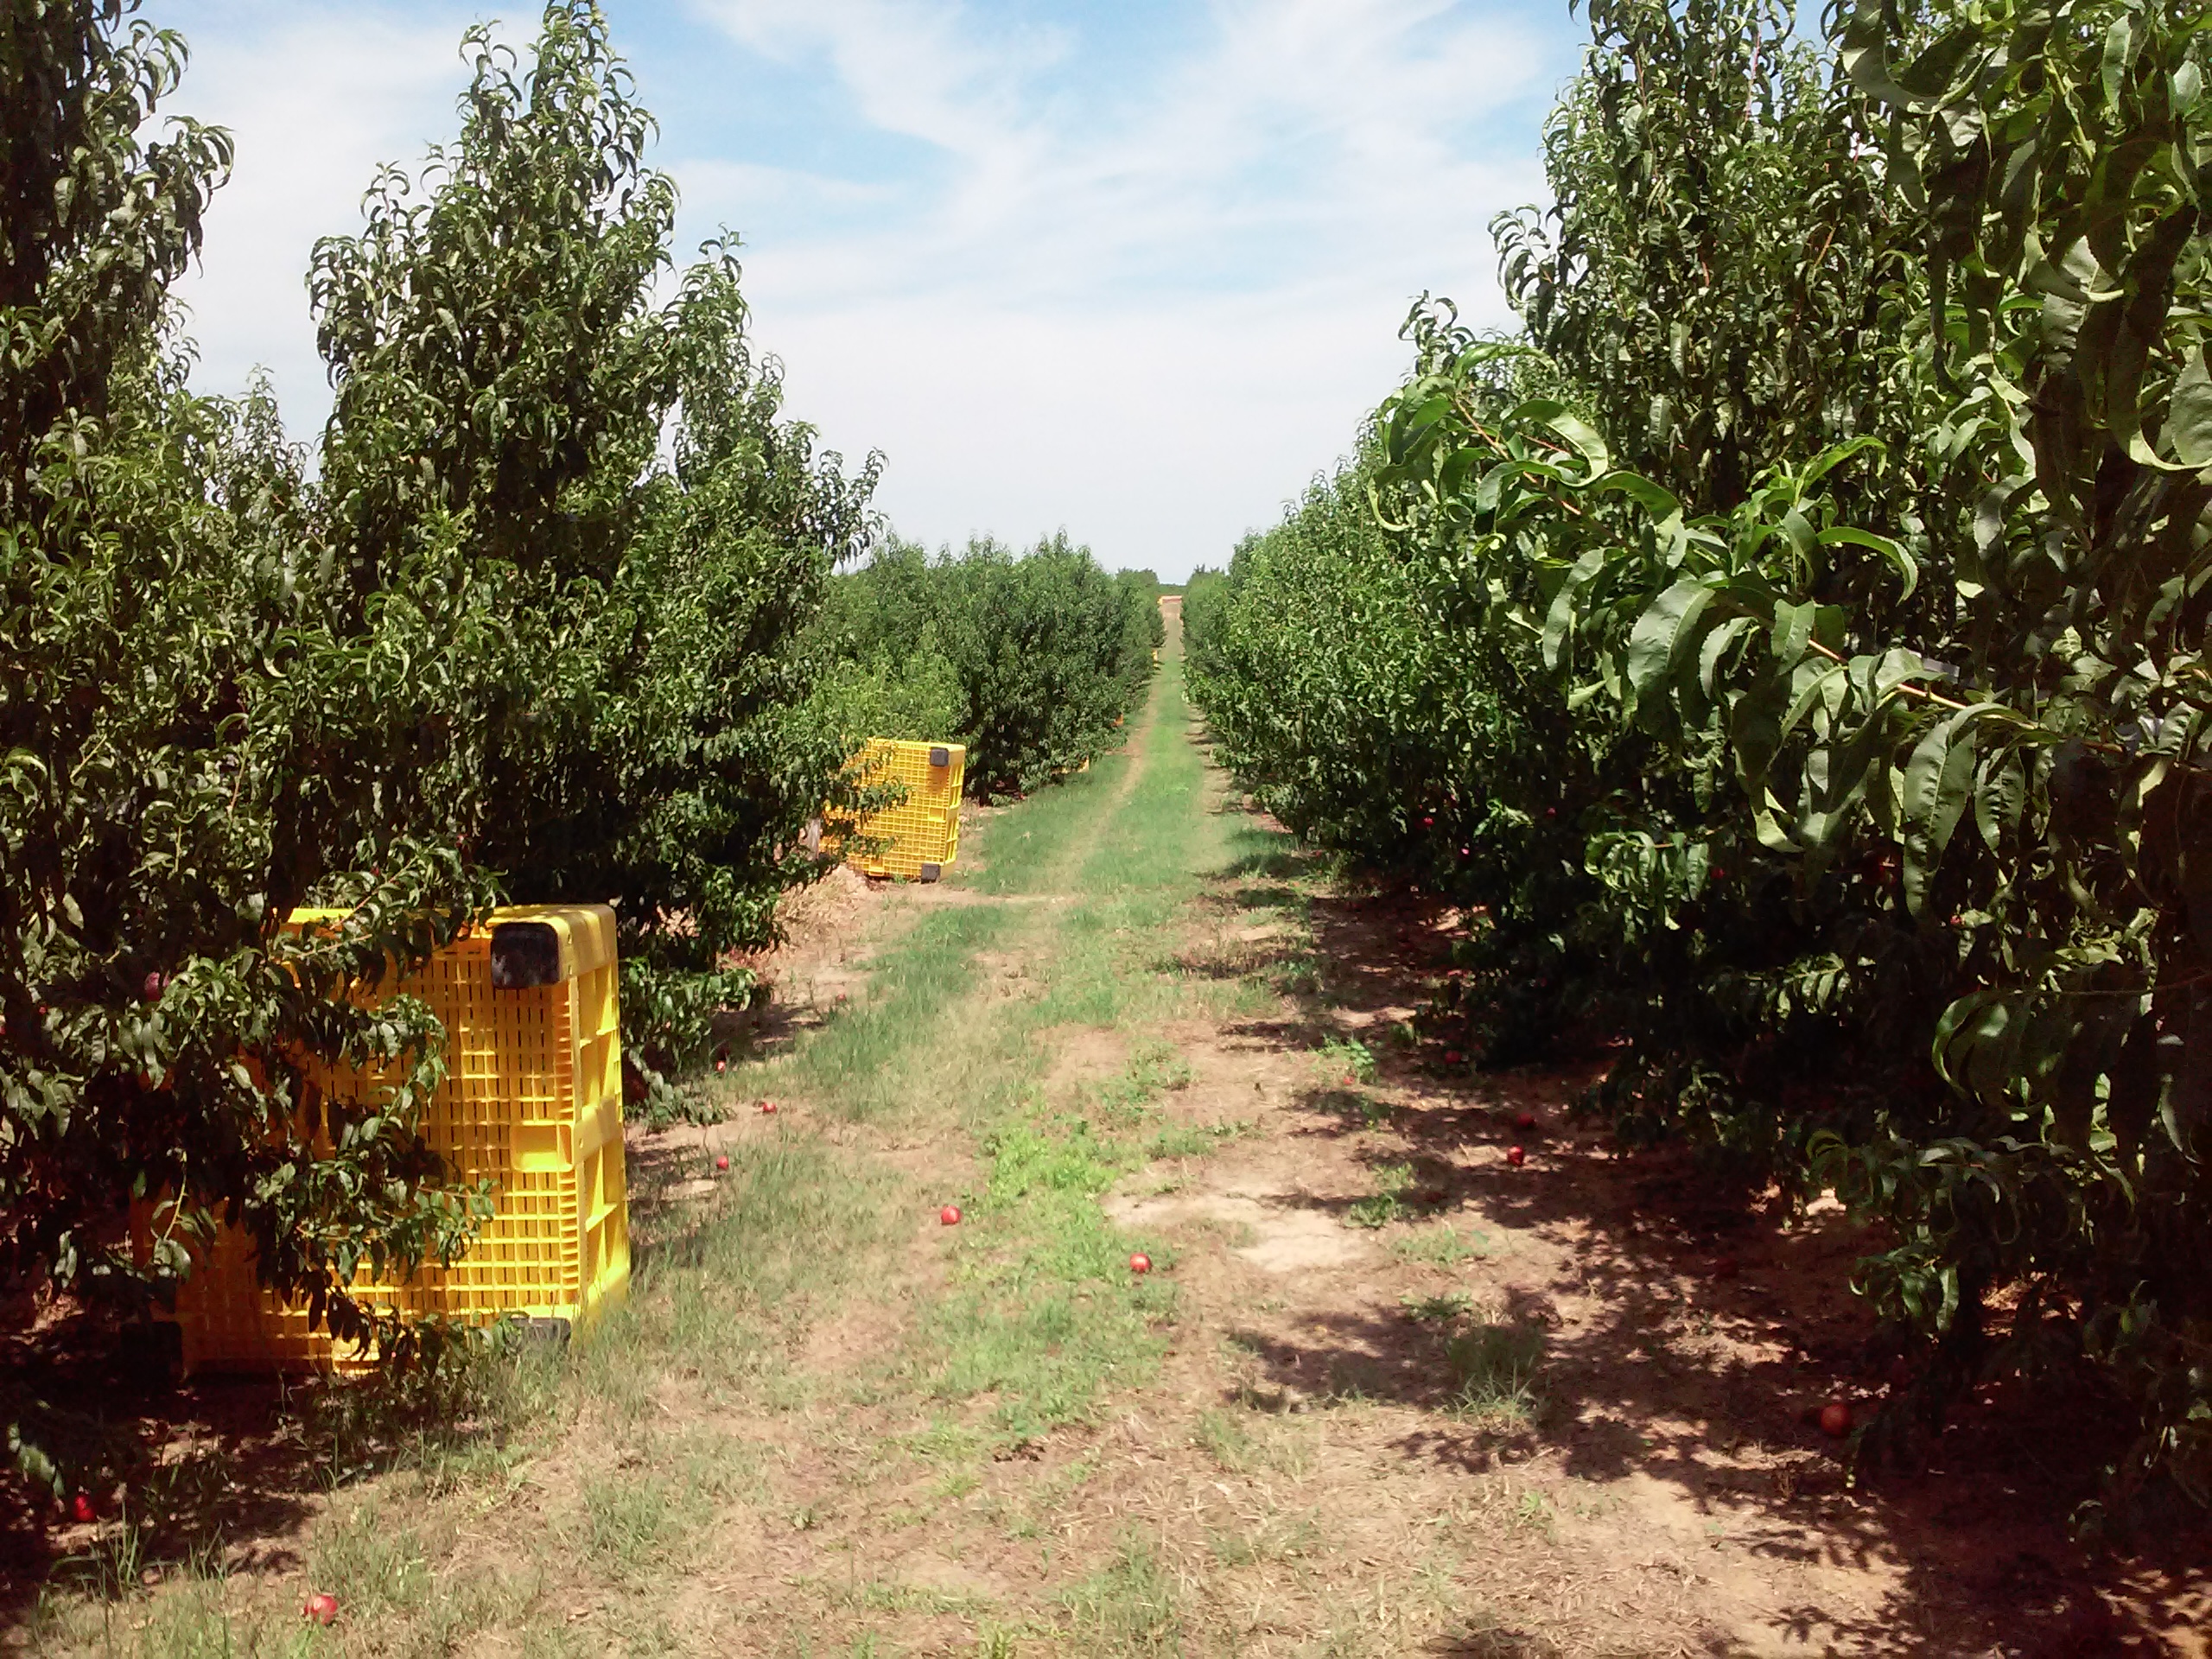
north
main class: Cropland
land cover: Other fruit trees and berries
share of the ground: > 75 %
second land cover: Grassland without tree/shrub cover
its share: > 75 %
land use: Agriculture (excluding fallow land and kitchen gardens)
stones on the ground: 10 - 25 %
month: August
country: ES
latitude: 41.4809
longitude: 0.5153
